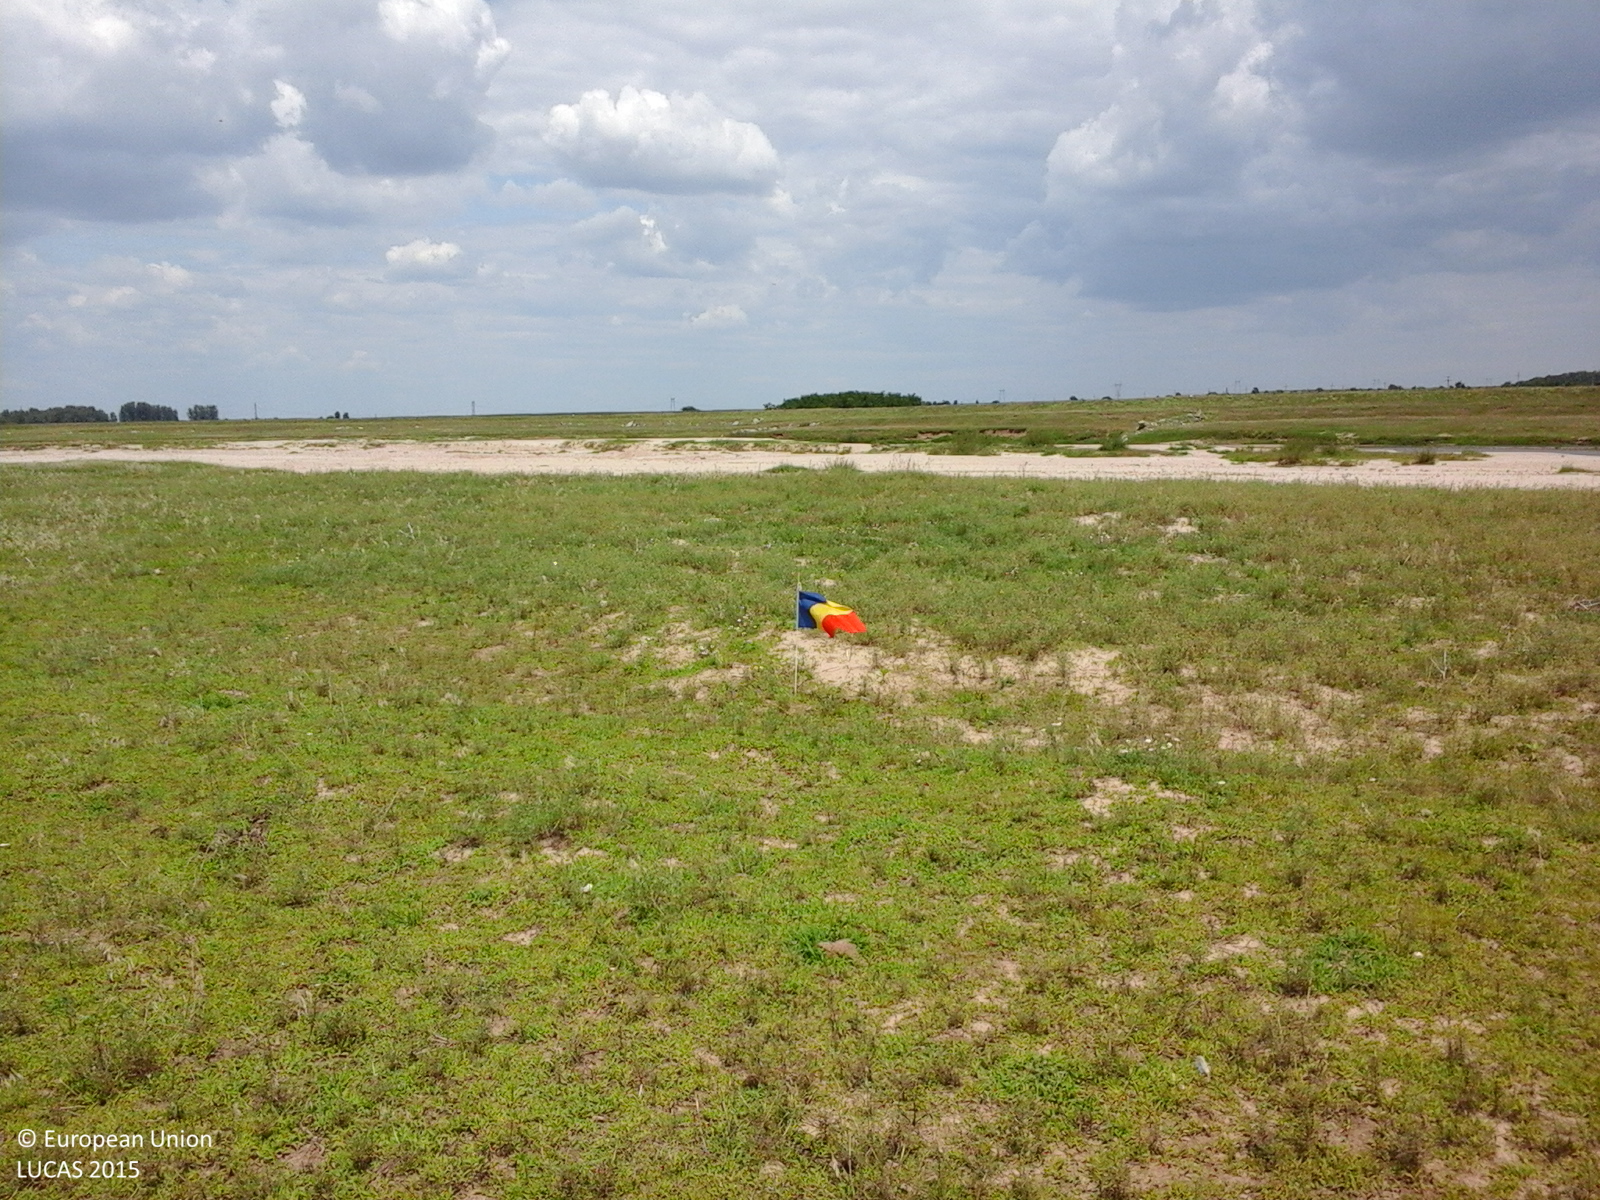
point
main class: Grassland
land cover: Spontaneously vegetated surfaces
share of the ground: > 75 %
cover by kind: herbaceous plants 100 %
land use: Agriculture (excluding fallow land and kitchen gardens)
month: July
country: RO
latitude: 44.2931
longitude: 24.7754
